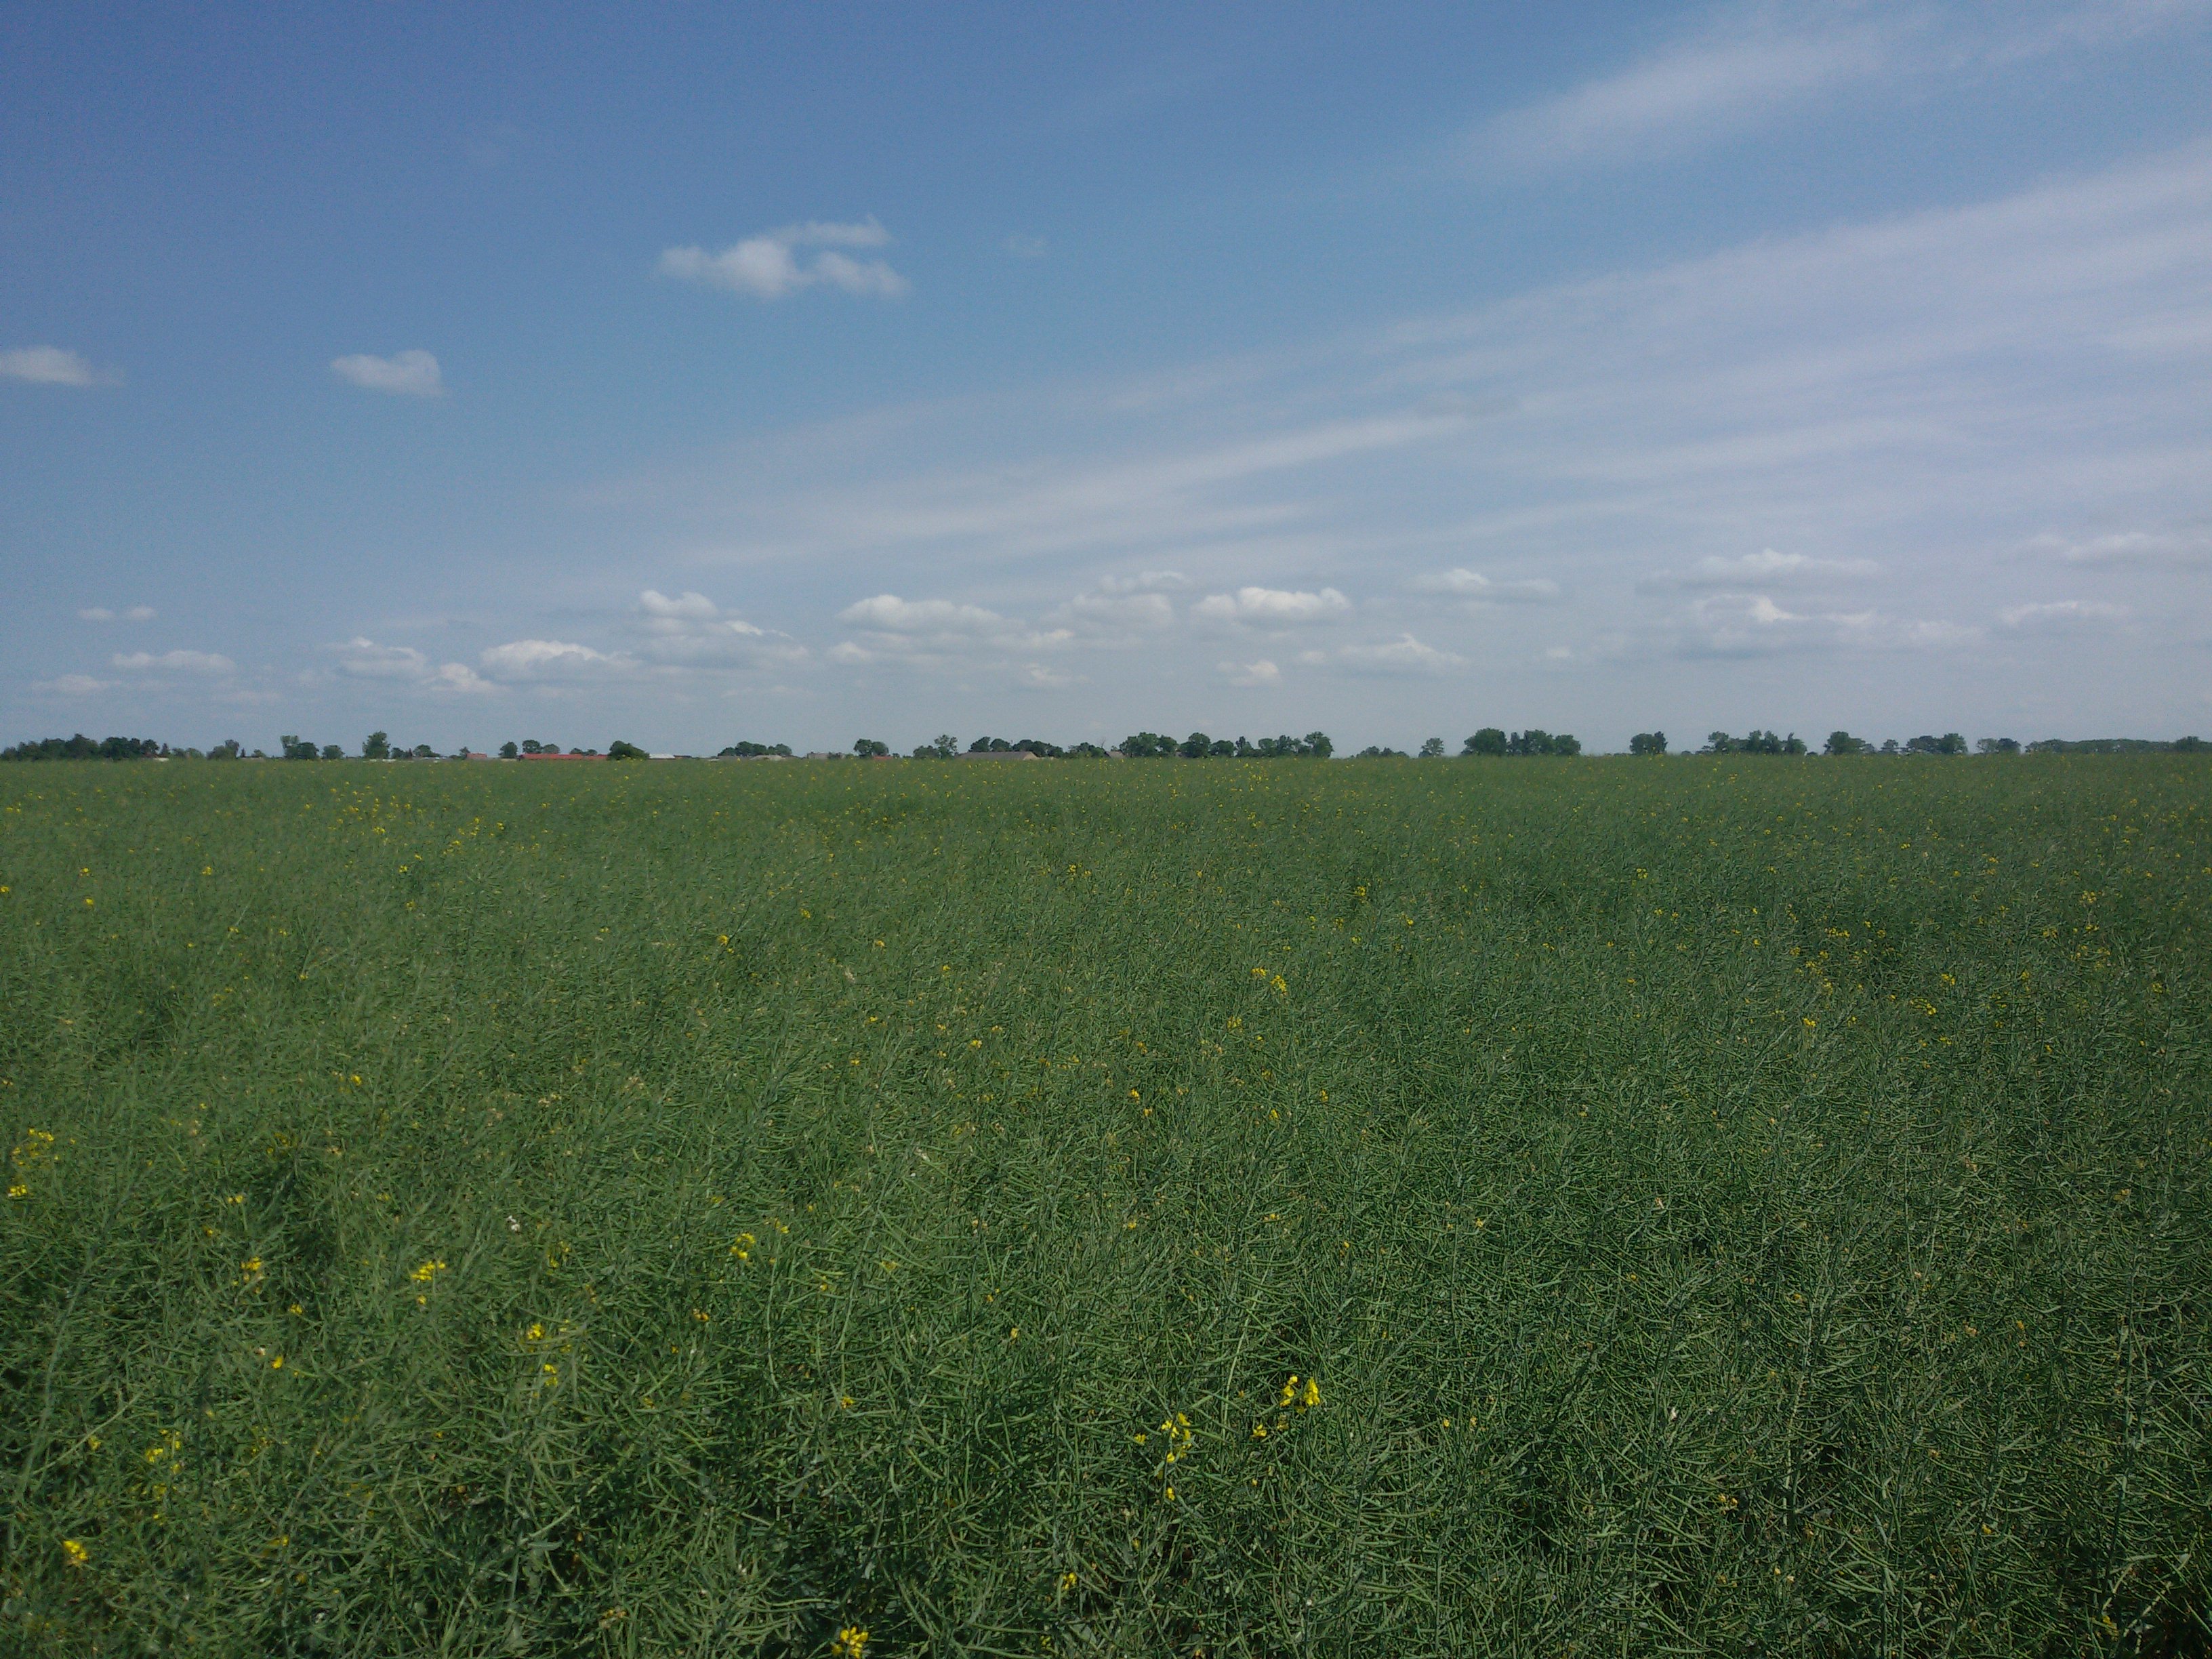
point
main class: Cropland
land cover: Rape and turnip rape
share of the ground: > 75 %
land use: Agriculture (excluding fallow land and kitchen gardens)
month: May
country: PL
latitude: 52.2881
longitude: 17.1502
